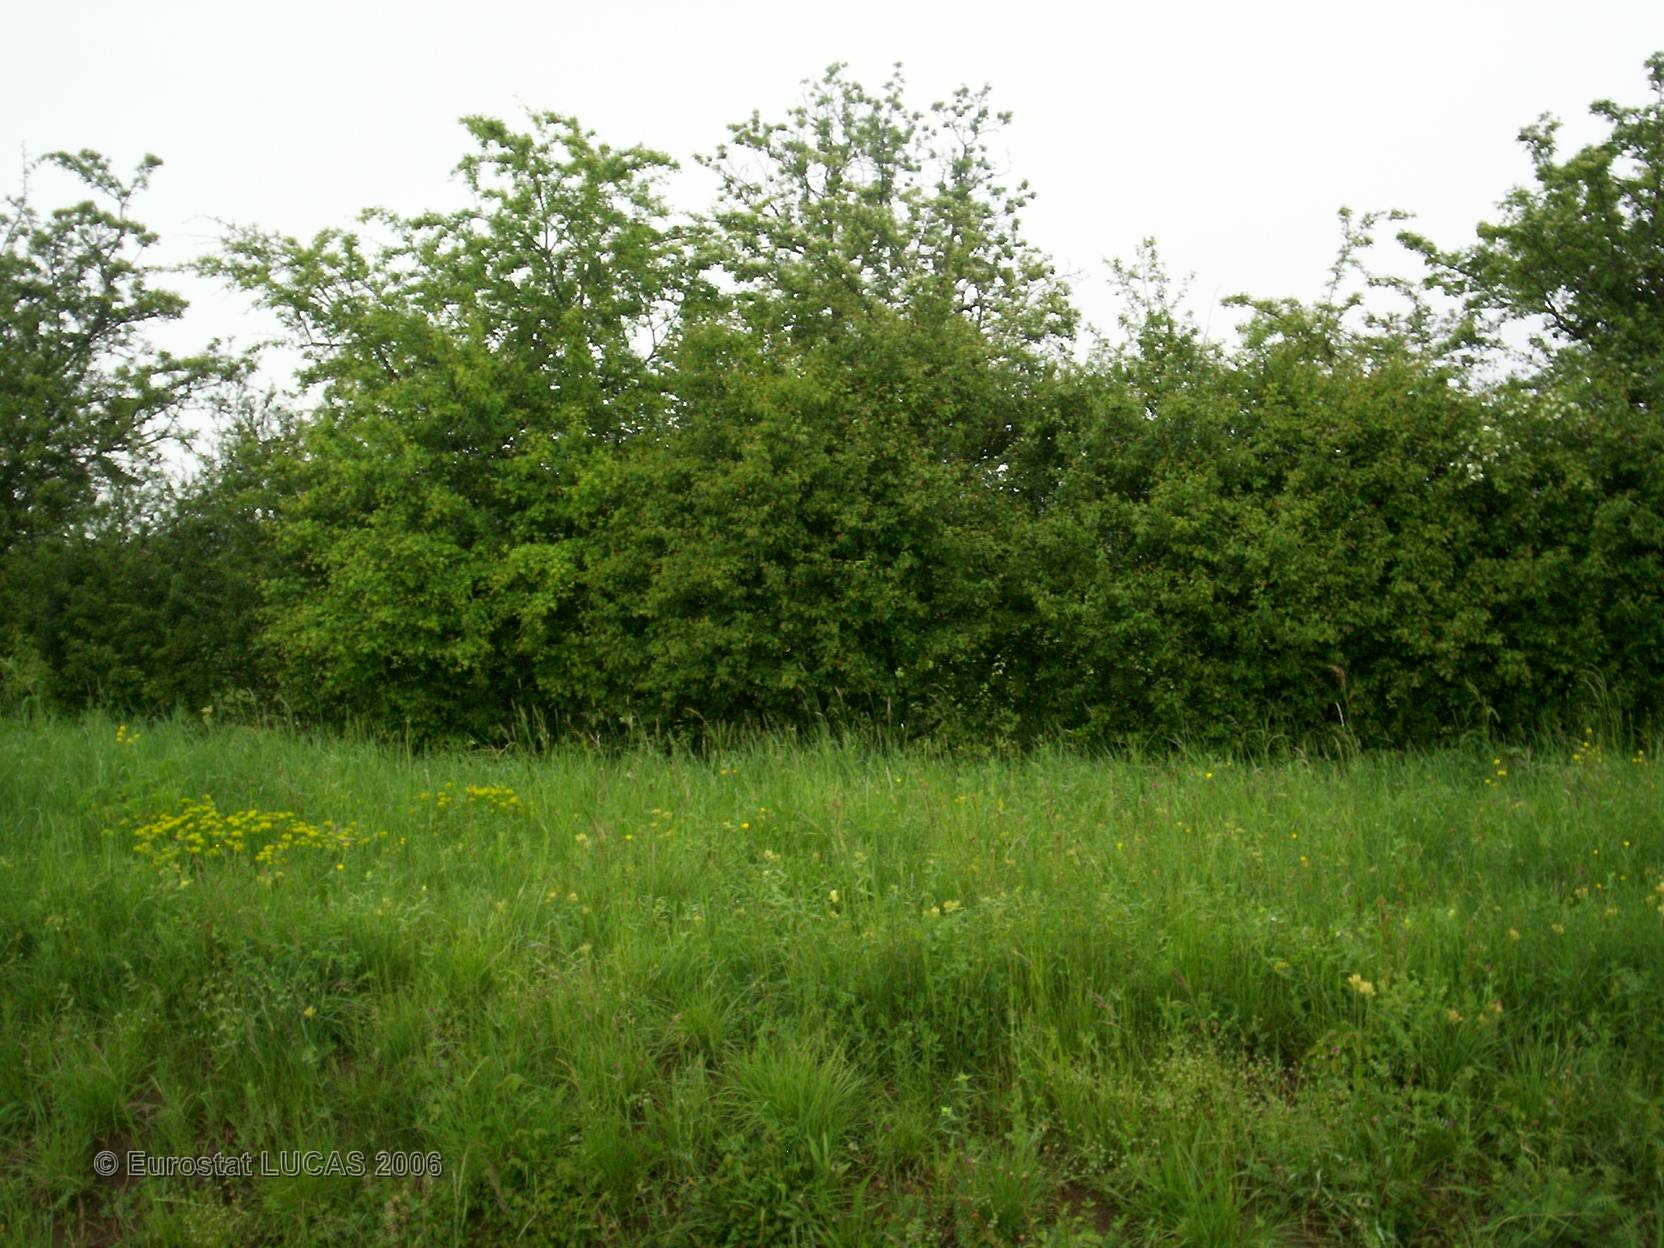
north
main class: Grassland
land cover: Grassland without tree/shrub cover
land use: Agriculture (excluding fallow land and kitchen gardens)
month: May
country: FR
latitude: 47.2420
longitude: 4.5702
